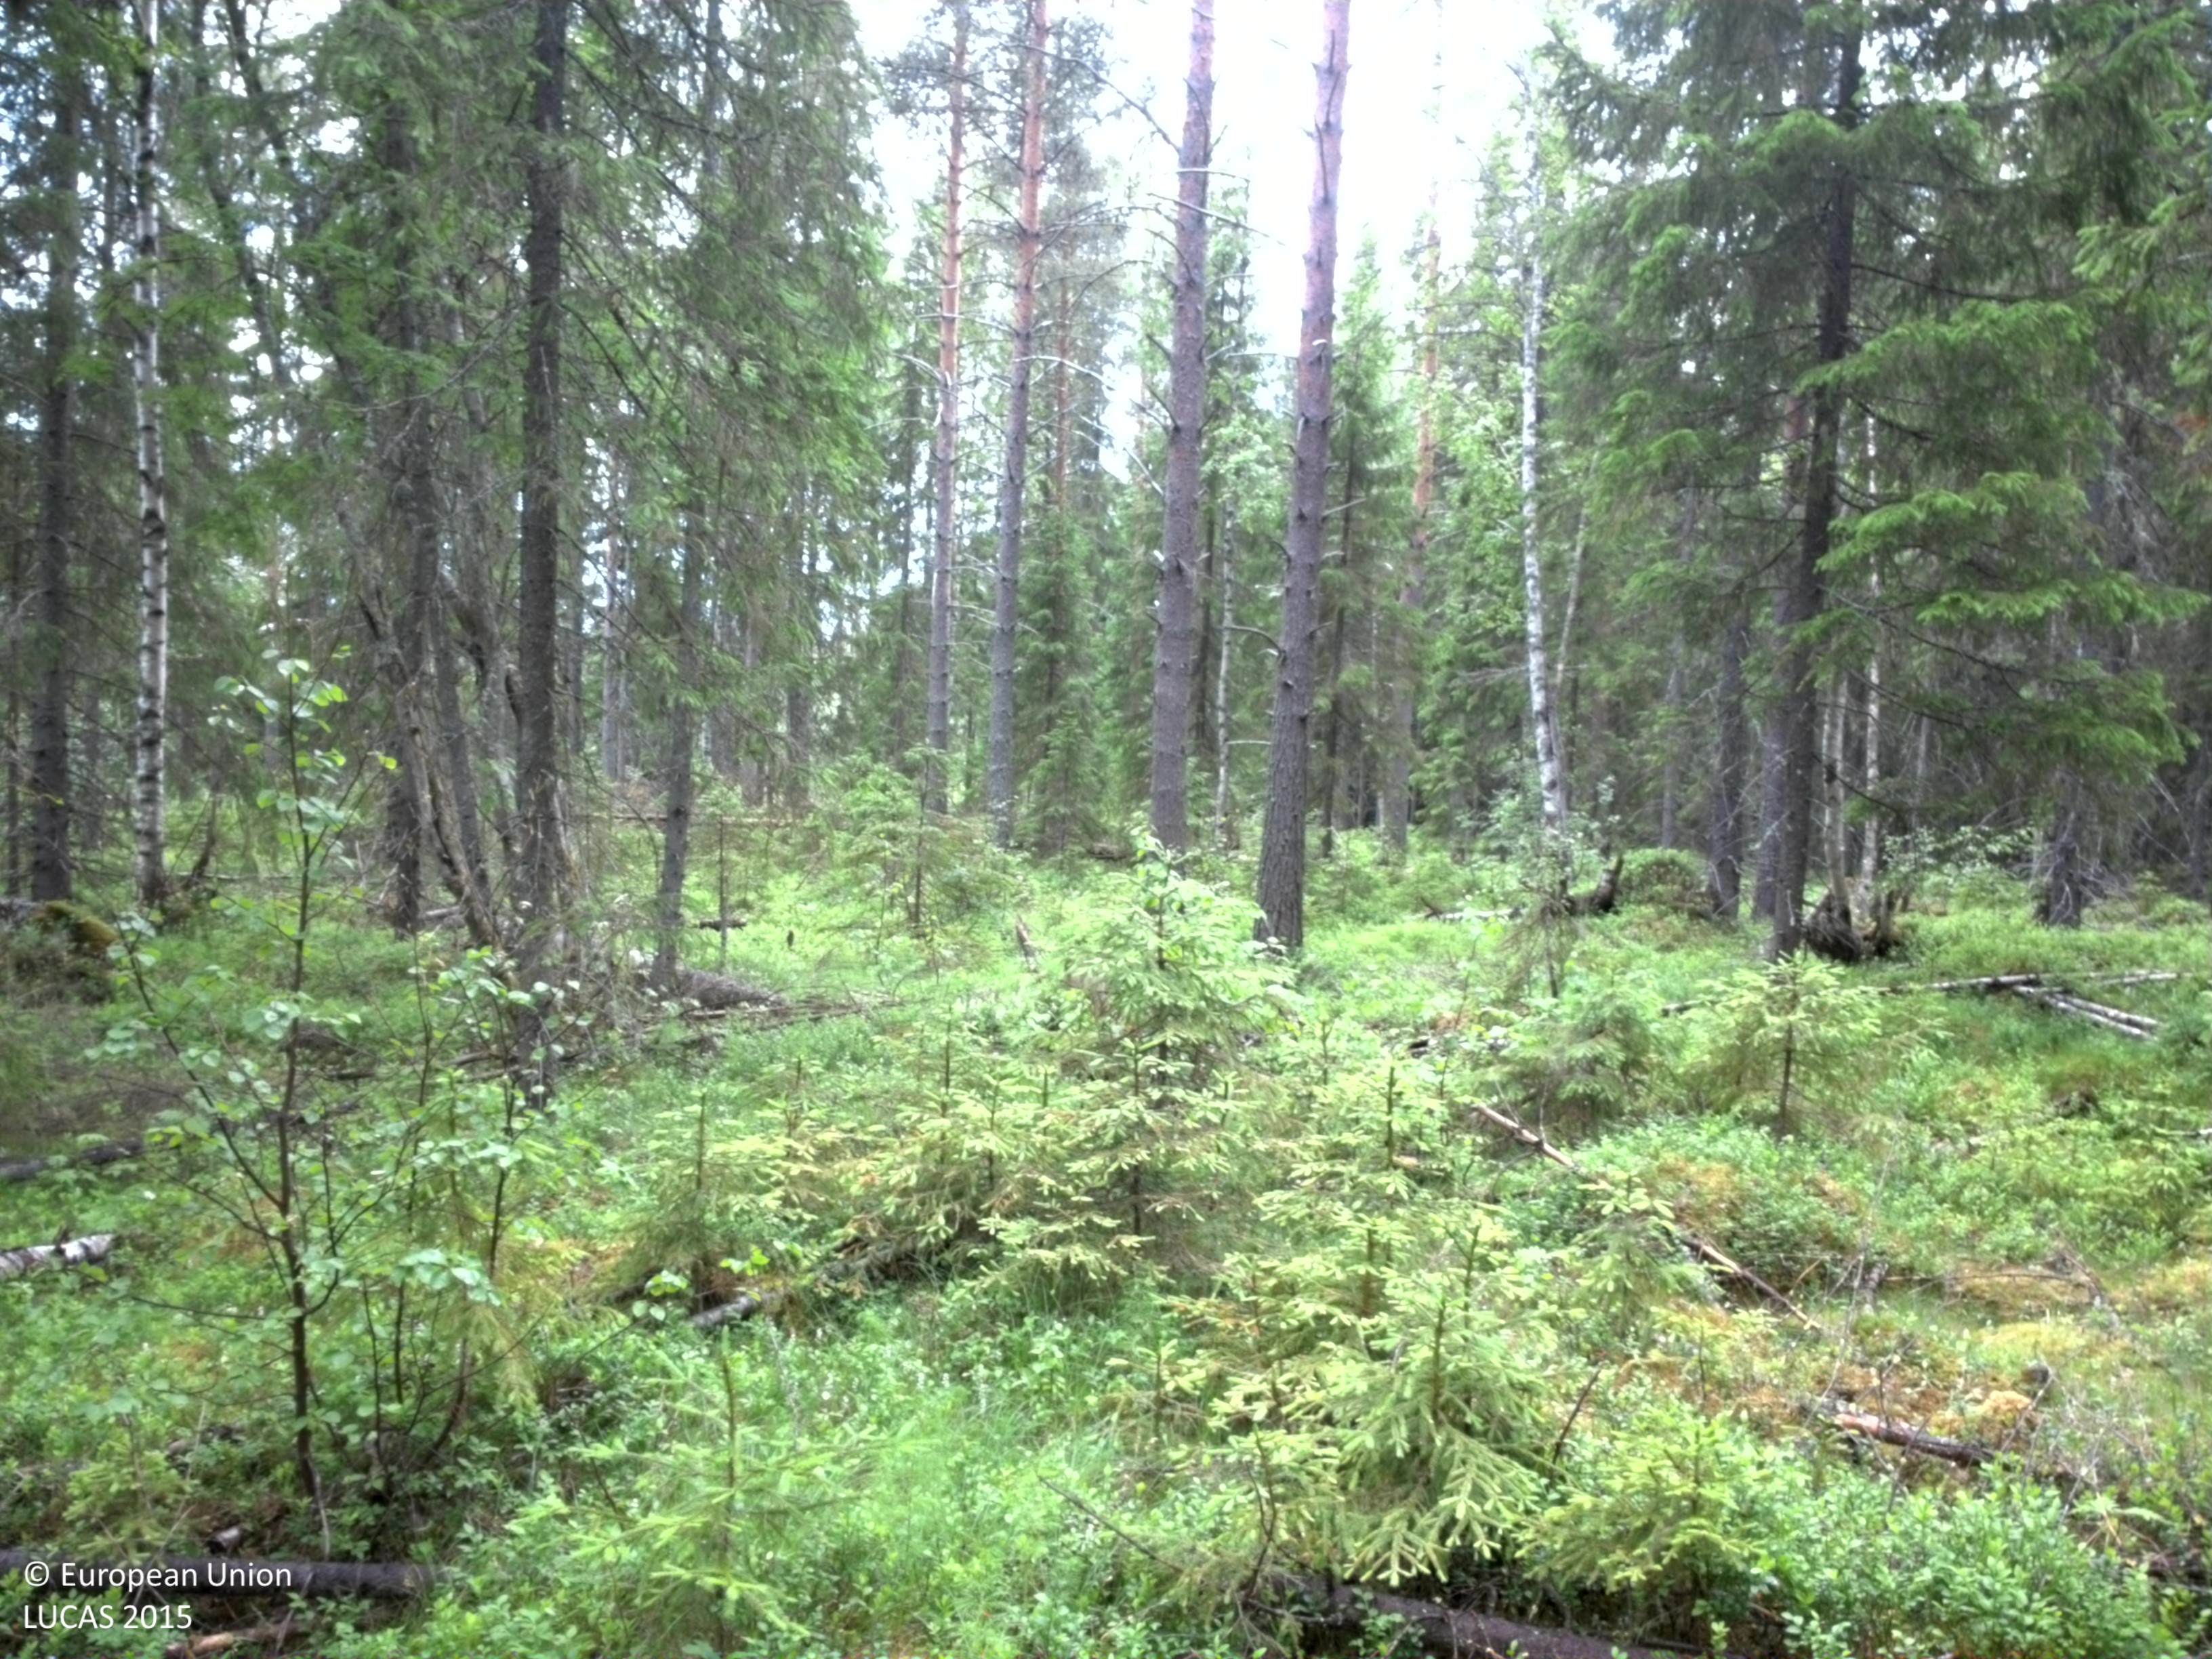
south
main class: Woodland
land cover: Spruce dominated coniferous woodland
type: boreal forest
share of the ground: 50 - 75 %
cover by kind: coniferous forest trees 45 %, shrubs 35 %, broadleaved forest trees 15 %, herbaceous plants 5 %
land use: Forestry
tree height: > 5 m
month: July
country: SE
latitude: 64.5346
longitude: 20.8814
